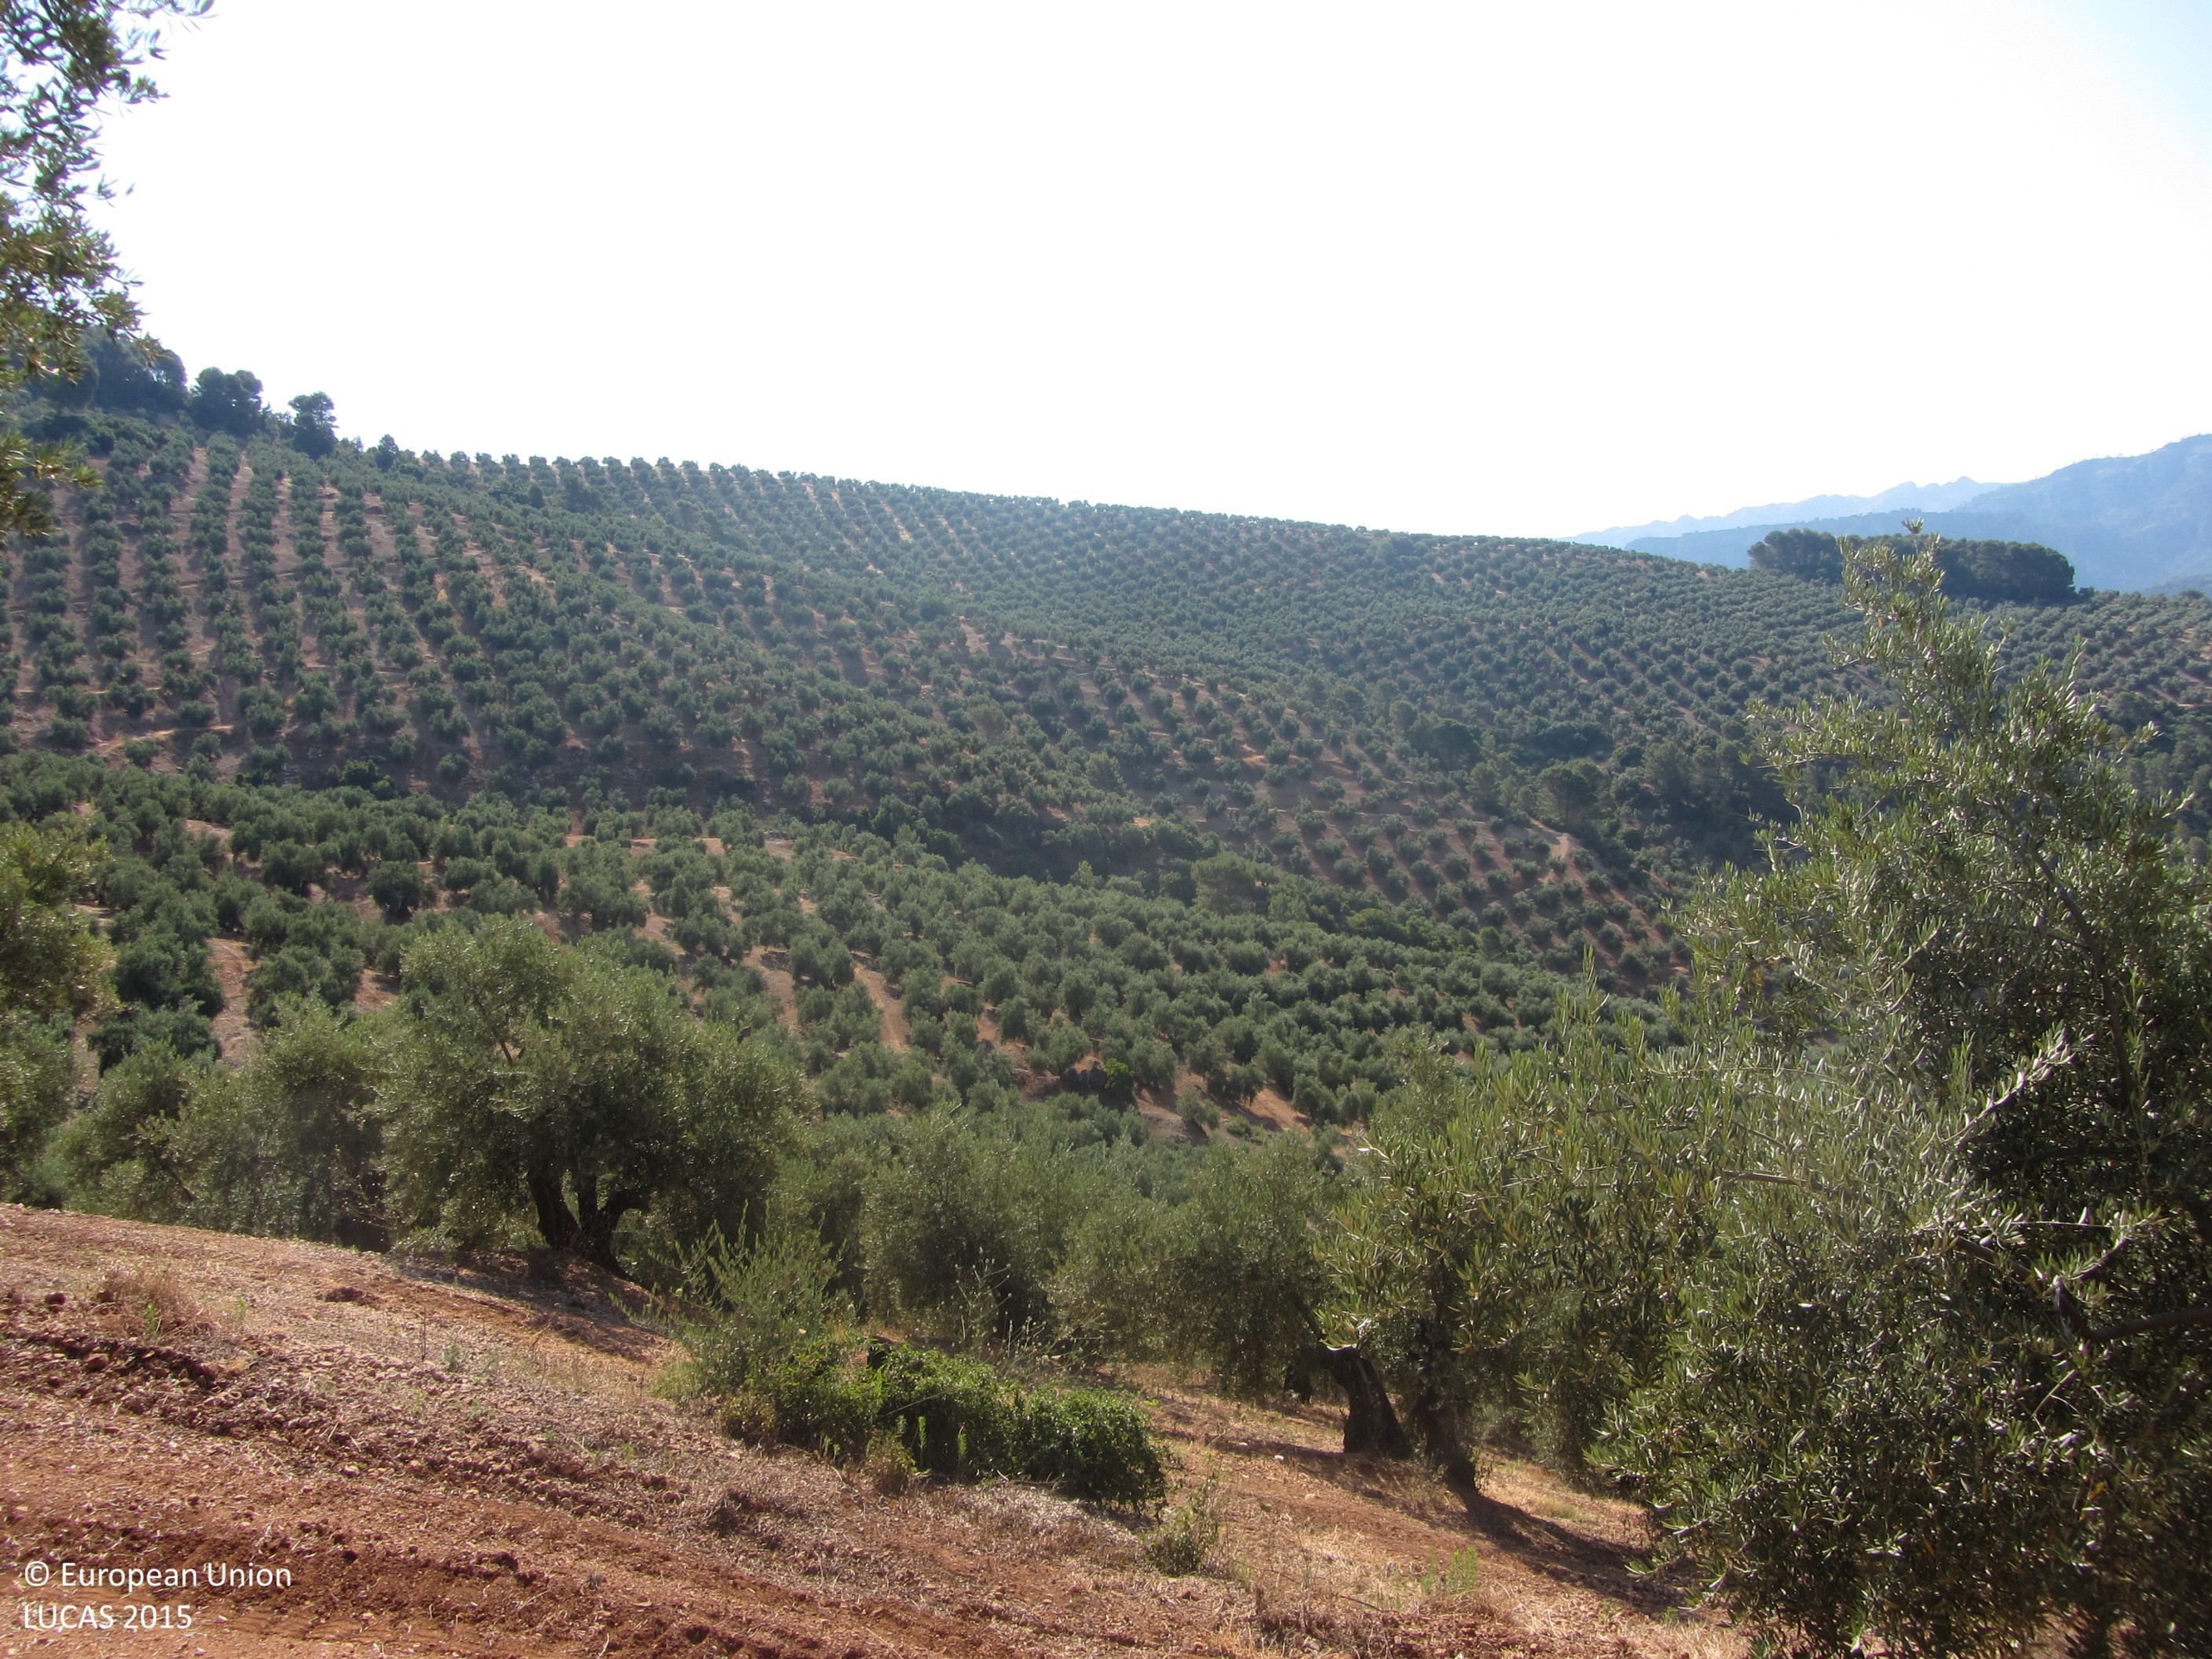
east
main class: Cropland
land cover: Olive groves
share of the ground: 25 - 50 %
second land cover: Other bare soil
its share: > 75 %
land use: Agriculture (excluding fallow land and kitchen gardens)
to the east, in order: Olive groves; Other bare soil; Tracks; Olive groves; Tracks; Olive groves; Rivers and streams; Olive groves; Tracks; Olive groves
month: June
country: ES
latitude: 38.2014
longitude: -2.9137
